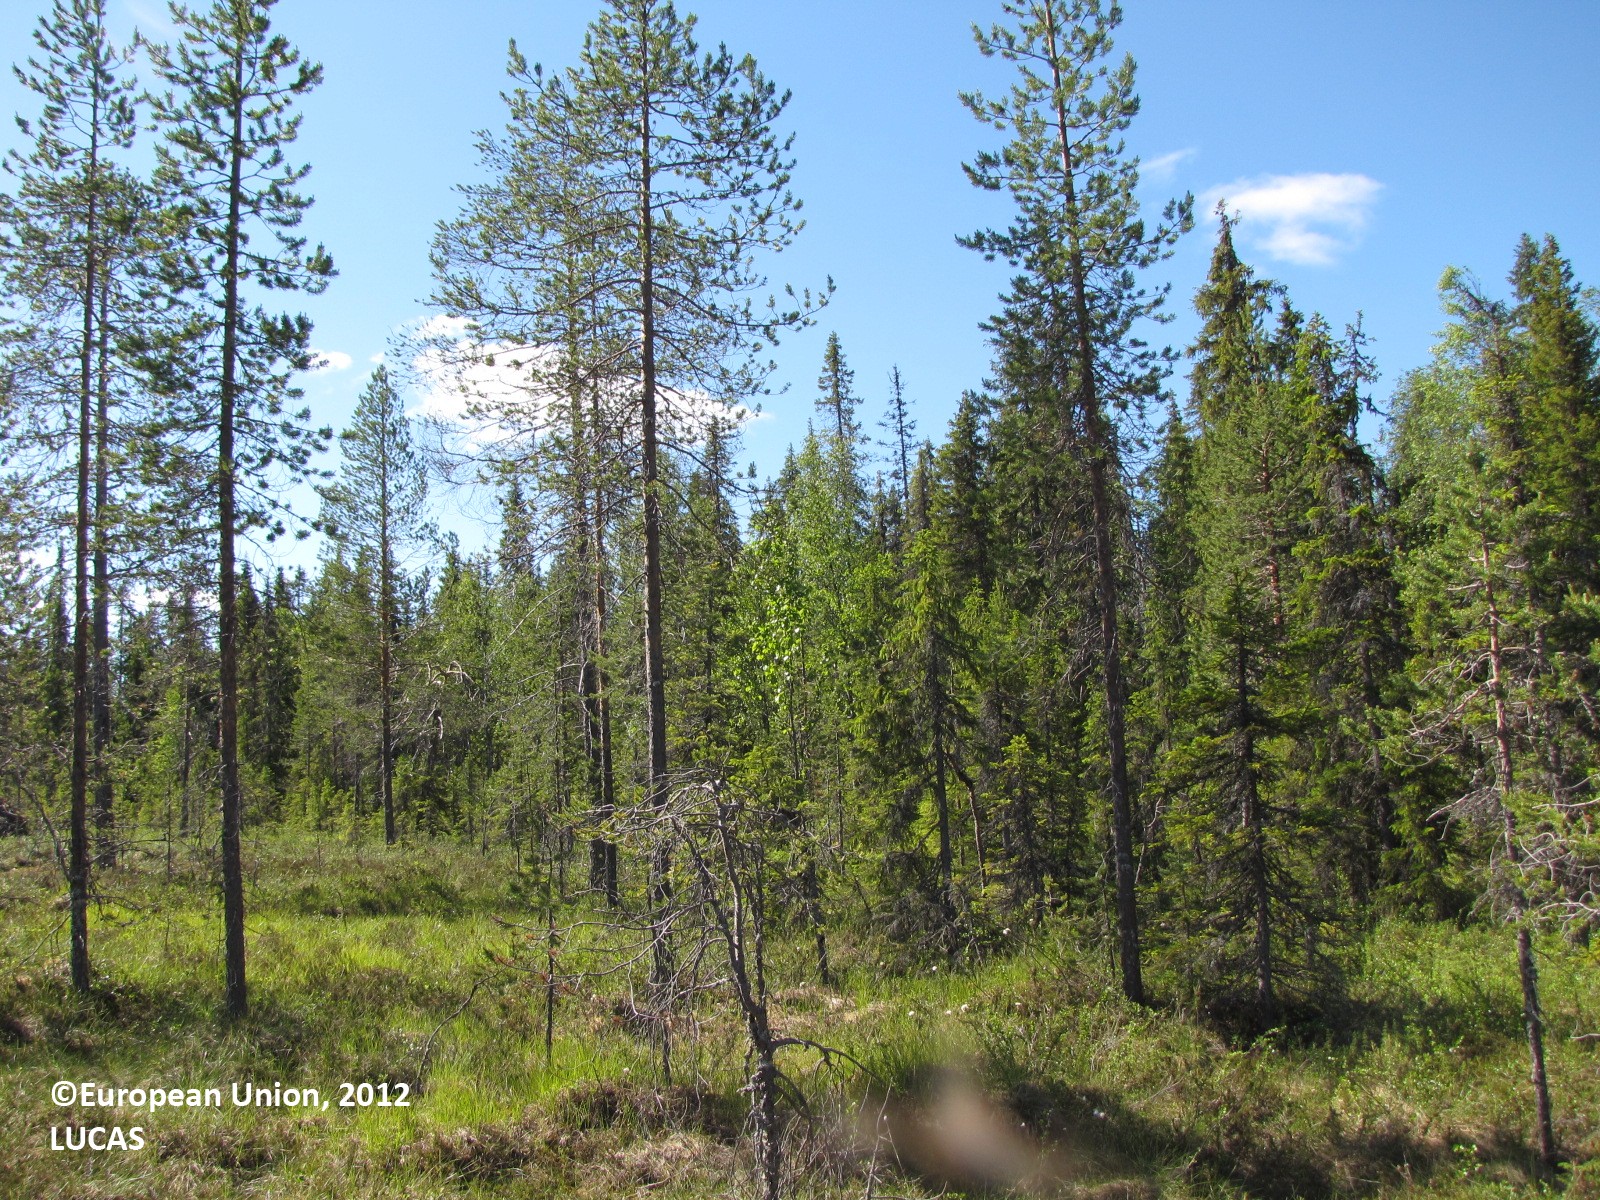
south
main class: Woodland
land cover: Pine dominated coniferous woodland
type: boreal forest
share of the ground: 25 - 50 %
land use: Forestry
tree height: > 5 m
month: July
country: FI
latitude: 66.4659
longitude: 24.8414
